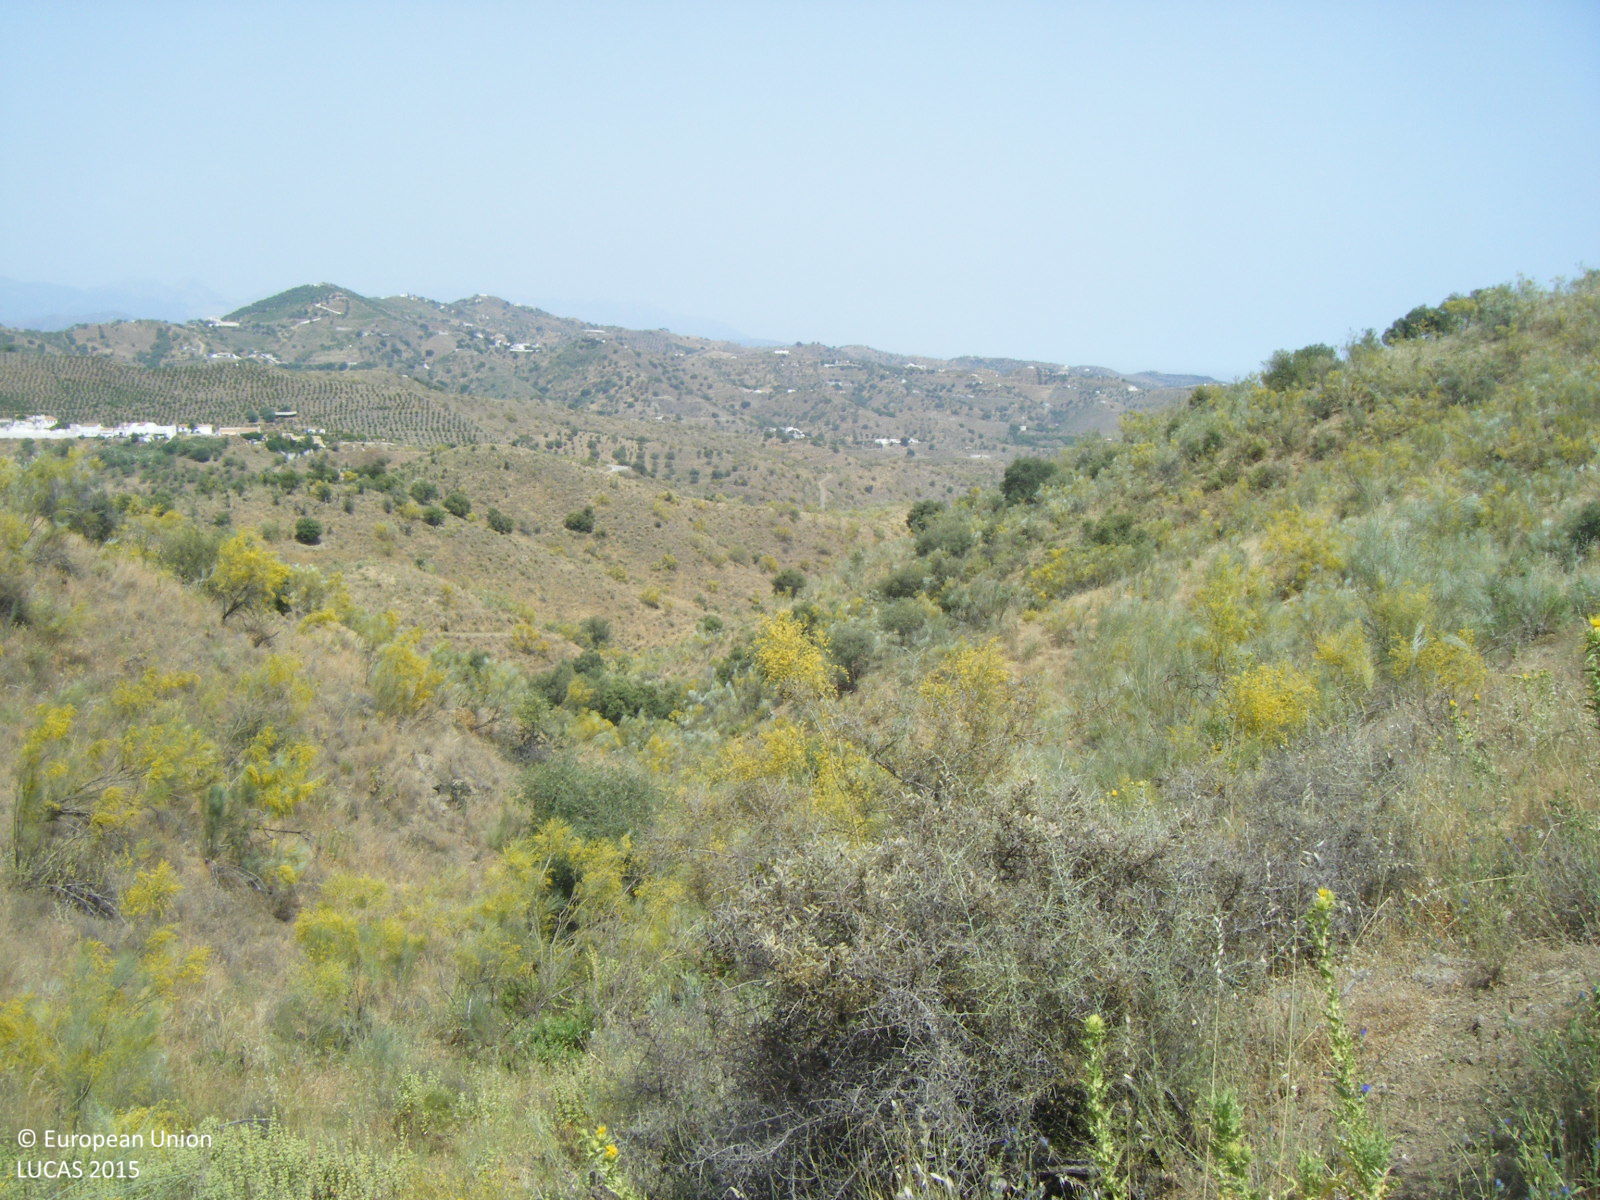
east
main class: Shrubland
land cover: Shrubland without tree cover
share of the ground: 50 - 75 %
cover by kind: shrubs 50 %, herbaceous plants 50 %
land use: Semi-natural and natural areas not in use
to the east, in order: Shrubland without tree cover
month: May
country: ES
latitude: 36.7639
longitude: -4.2269
